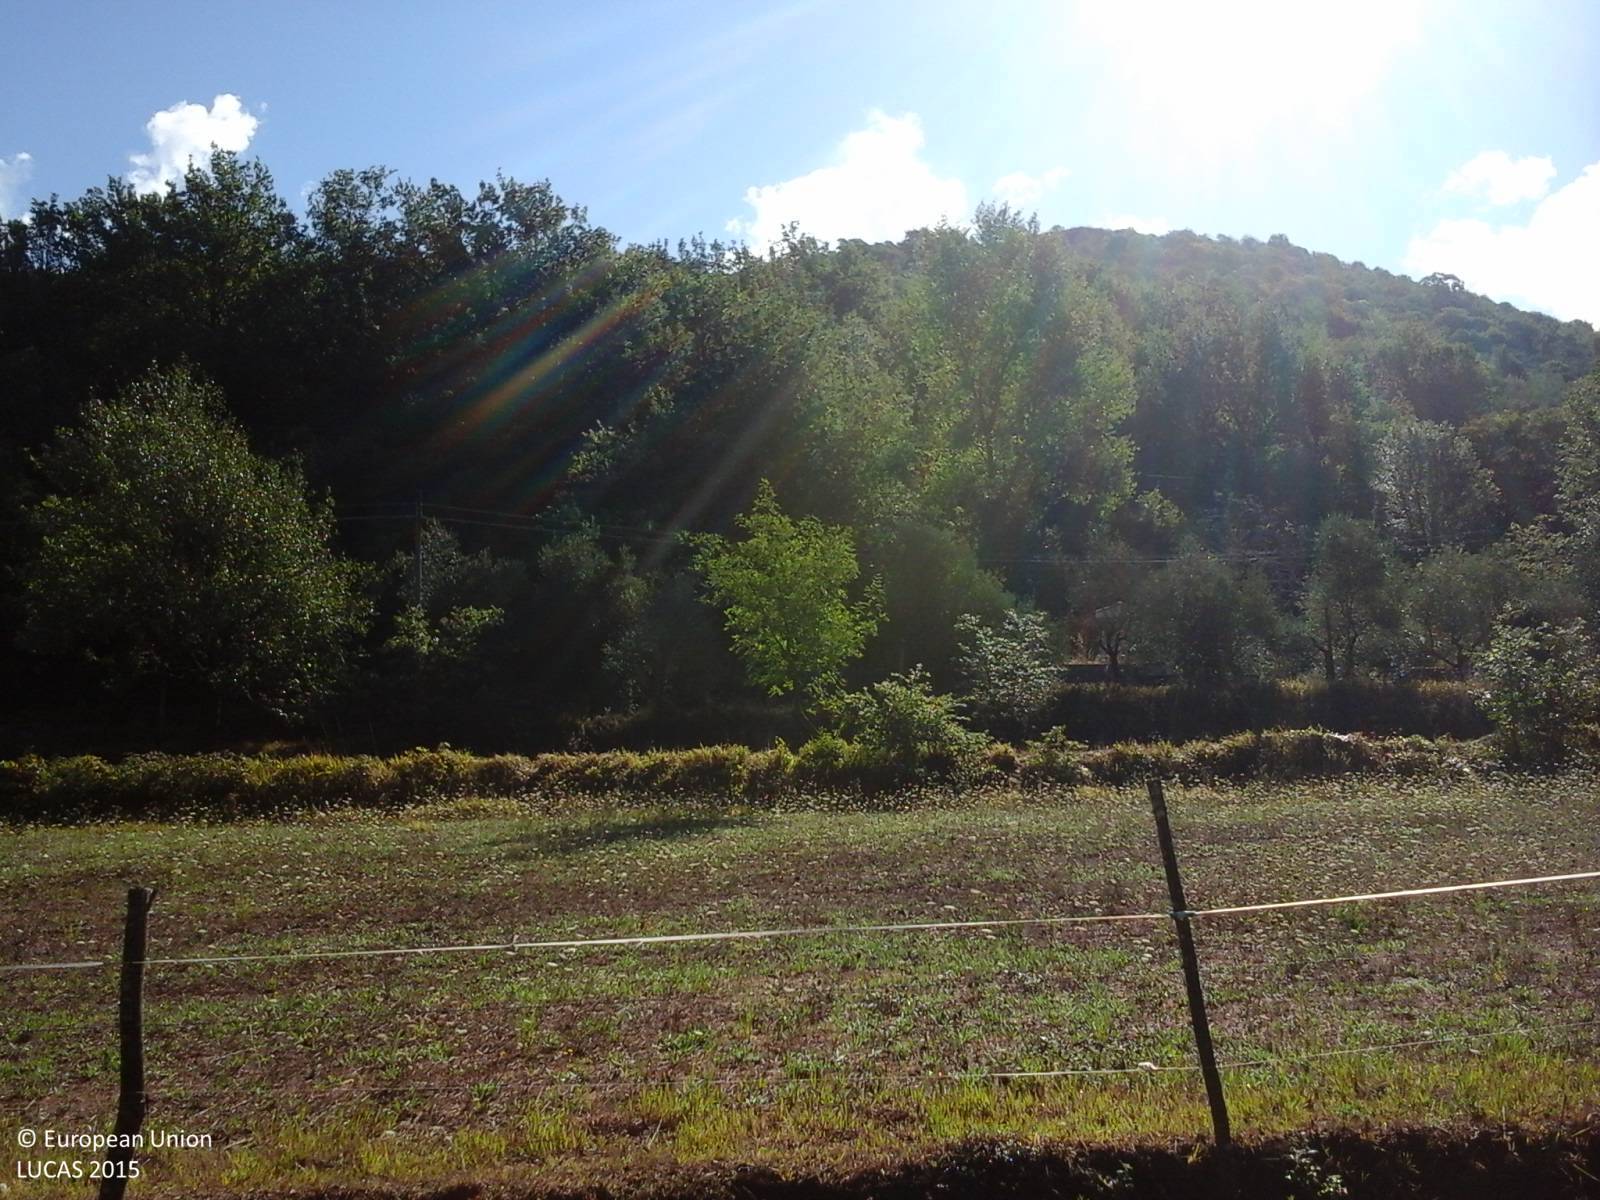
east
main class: Grassland
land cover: Grassland without tree/shrub cover
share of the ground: > 75 %
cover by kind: herbaceous plants 100 %
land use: Agriculture (excluding fallow land and kitchen gardens)
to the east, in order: Grassland without tree/shrub cover; Fences; Grassland without tree/shrub cover; Shruby margins; Spontaneously vegetated surfaces; Olive groves; Electric lines; Shruby margins; Paved roads, cycling and walking lanes; Broadleaved woodland; Electric lines; Broadleaved woodland; Permanent crops (only in case pi)
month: August
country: IT
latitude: 41.4216
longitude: 13.3967
